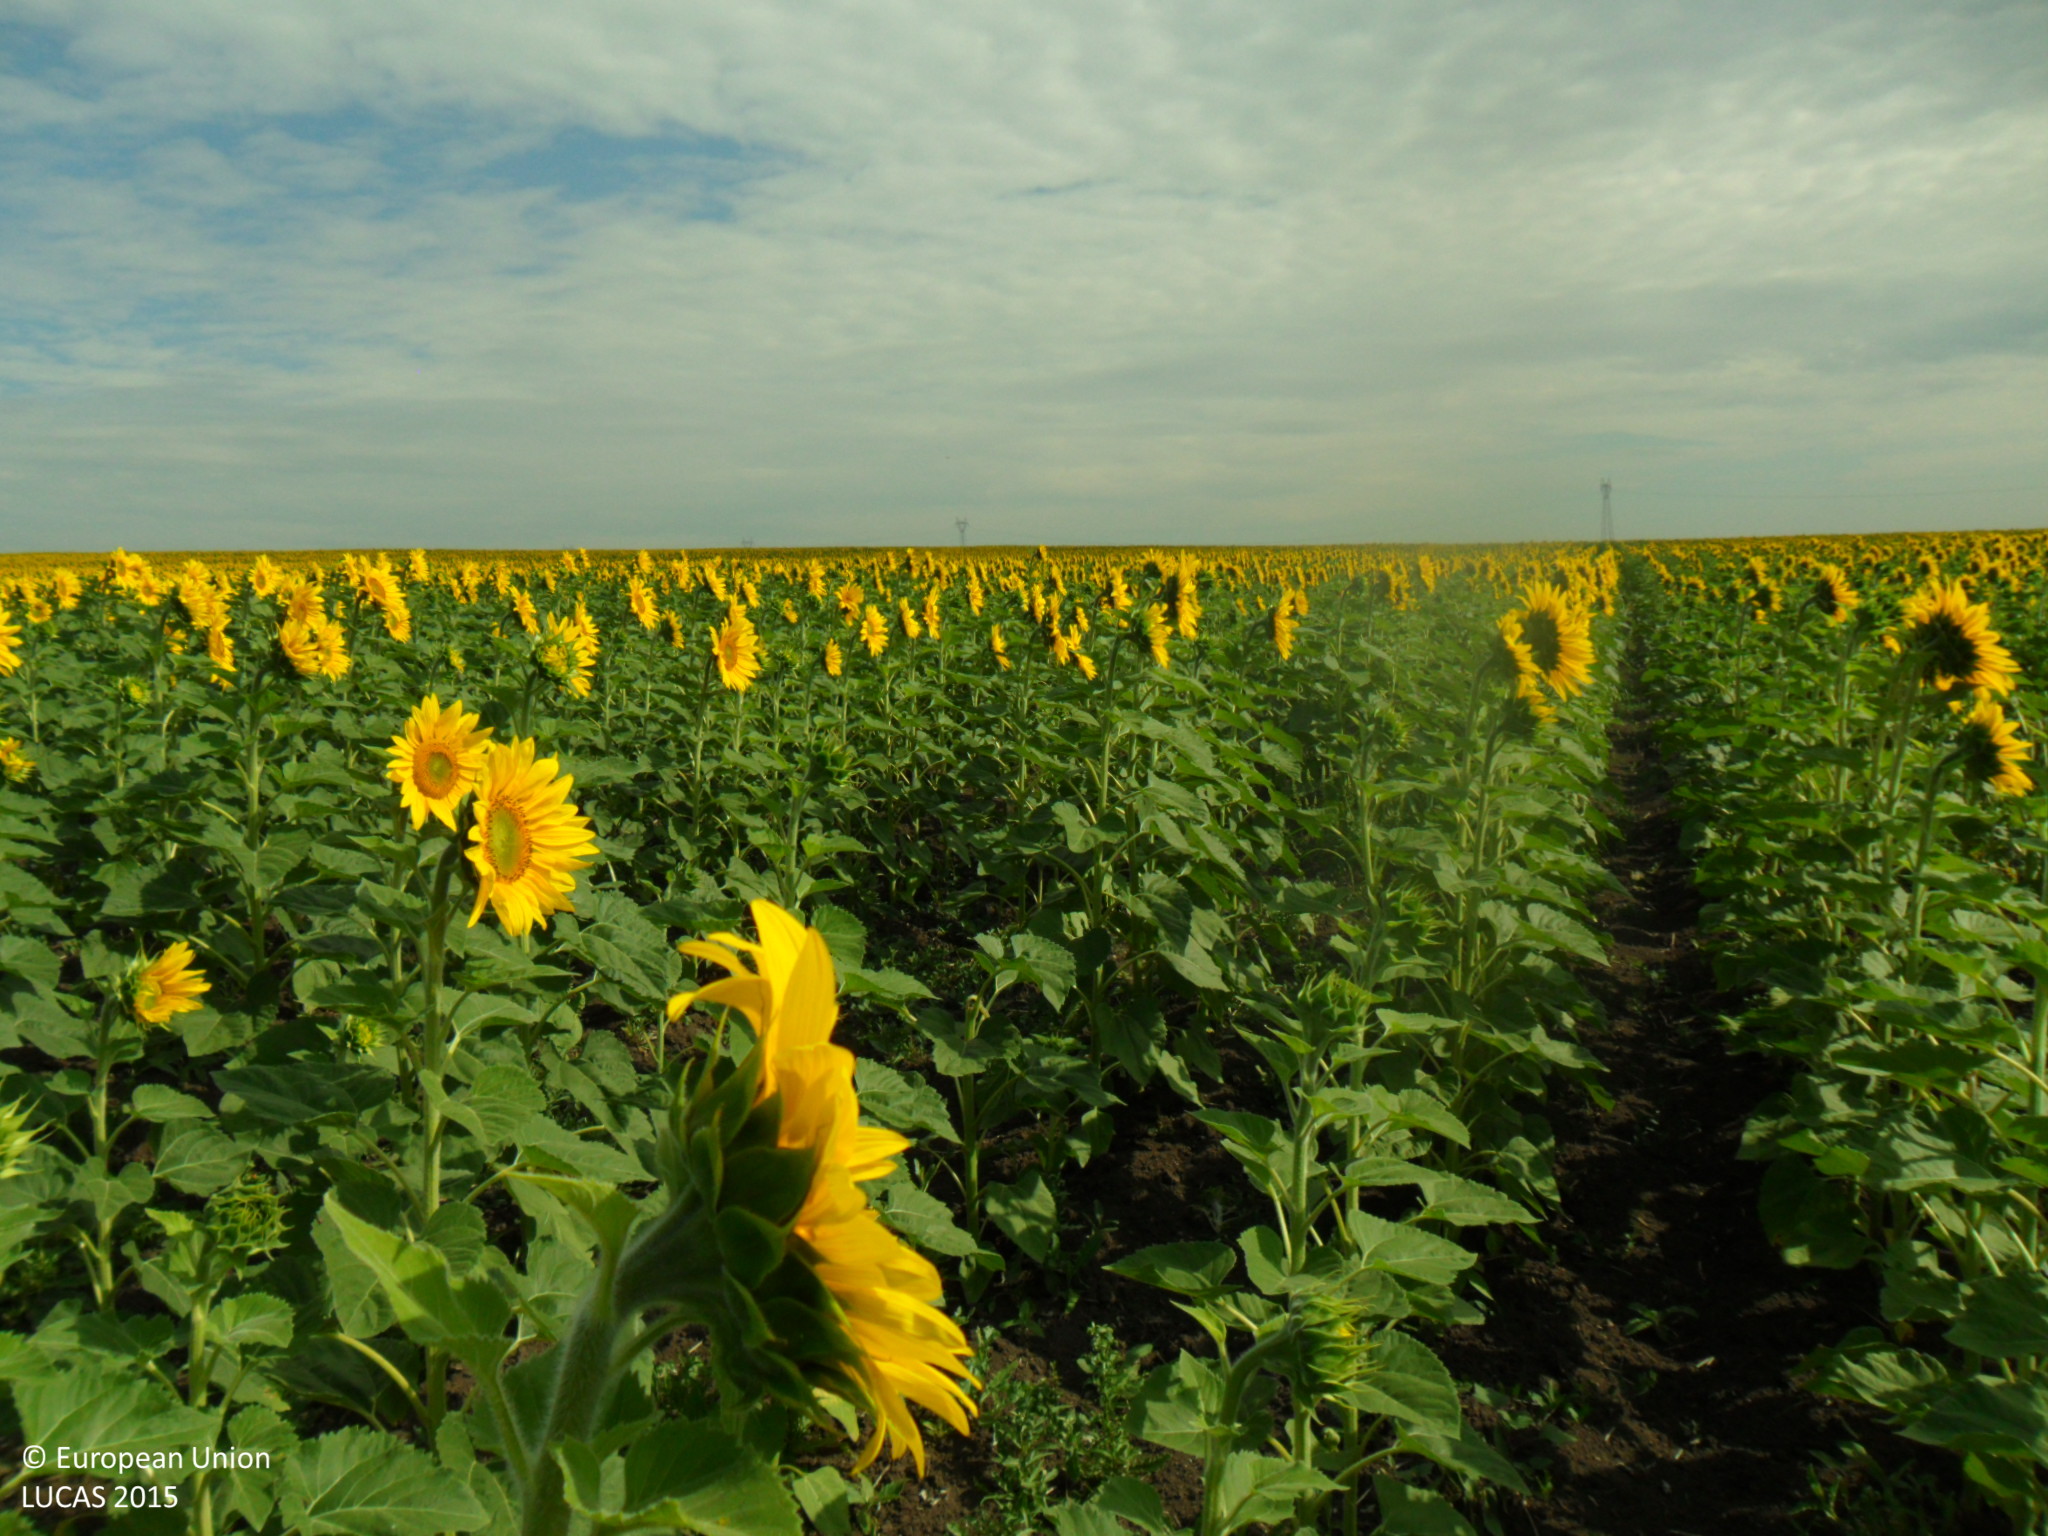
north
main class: Cropland
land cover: Sunflower
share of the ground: > 75 %
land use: Agriculture (excluding fallow land and kitchen gardens)
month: June
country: BG
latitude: 43.3721
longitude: 26.8089
